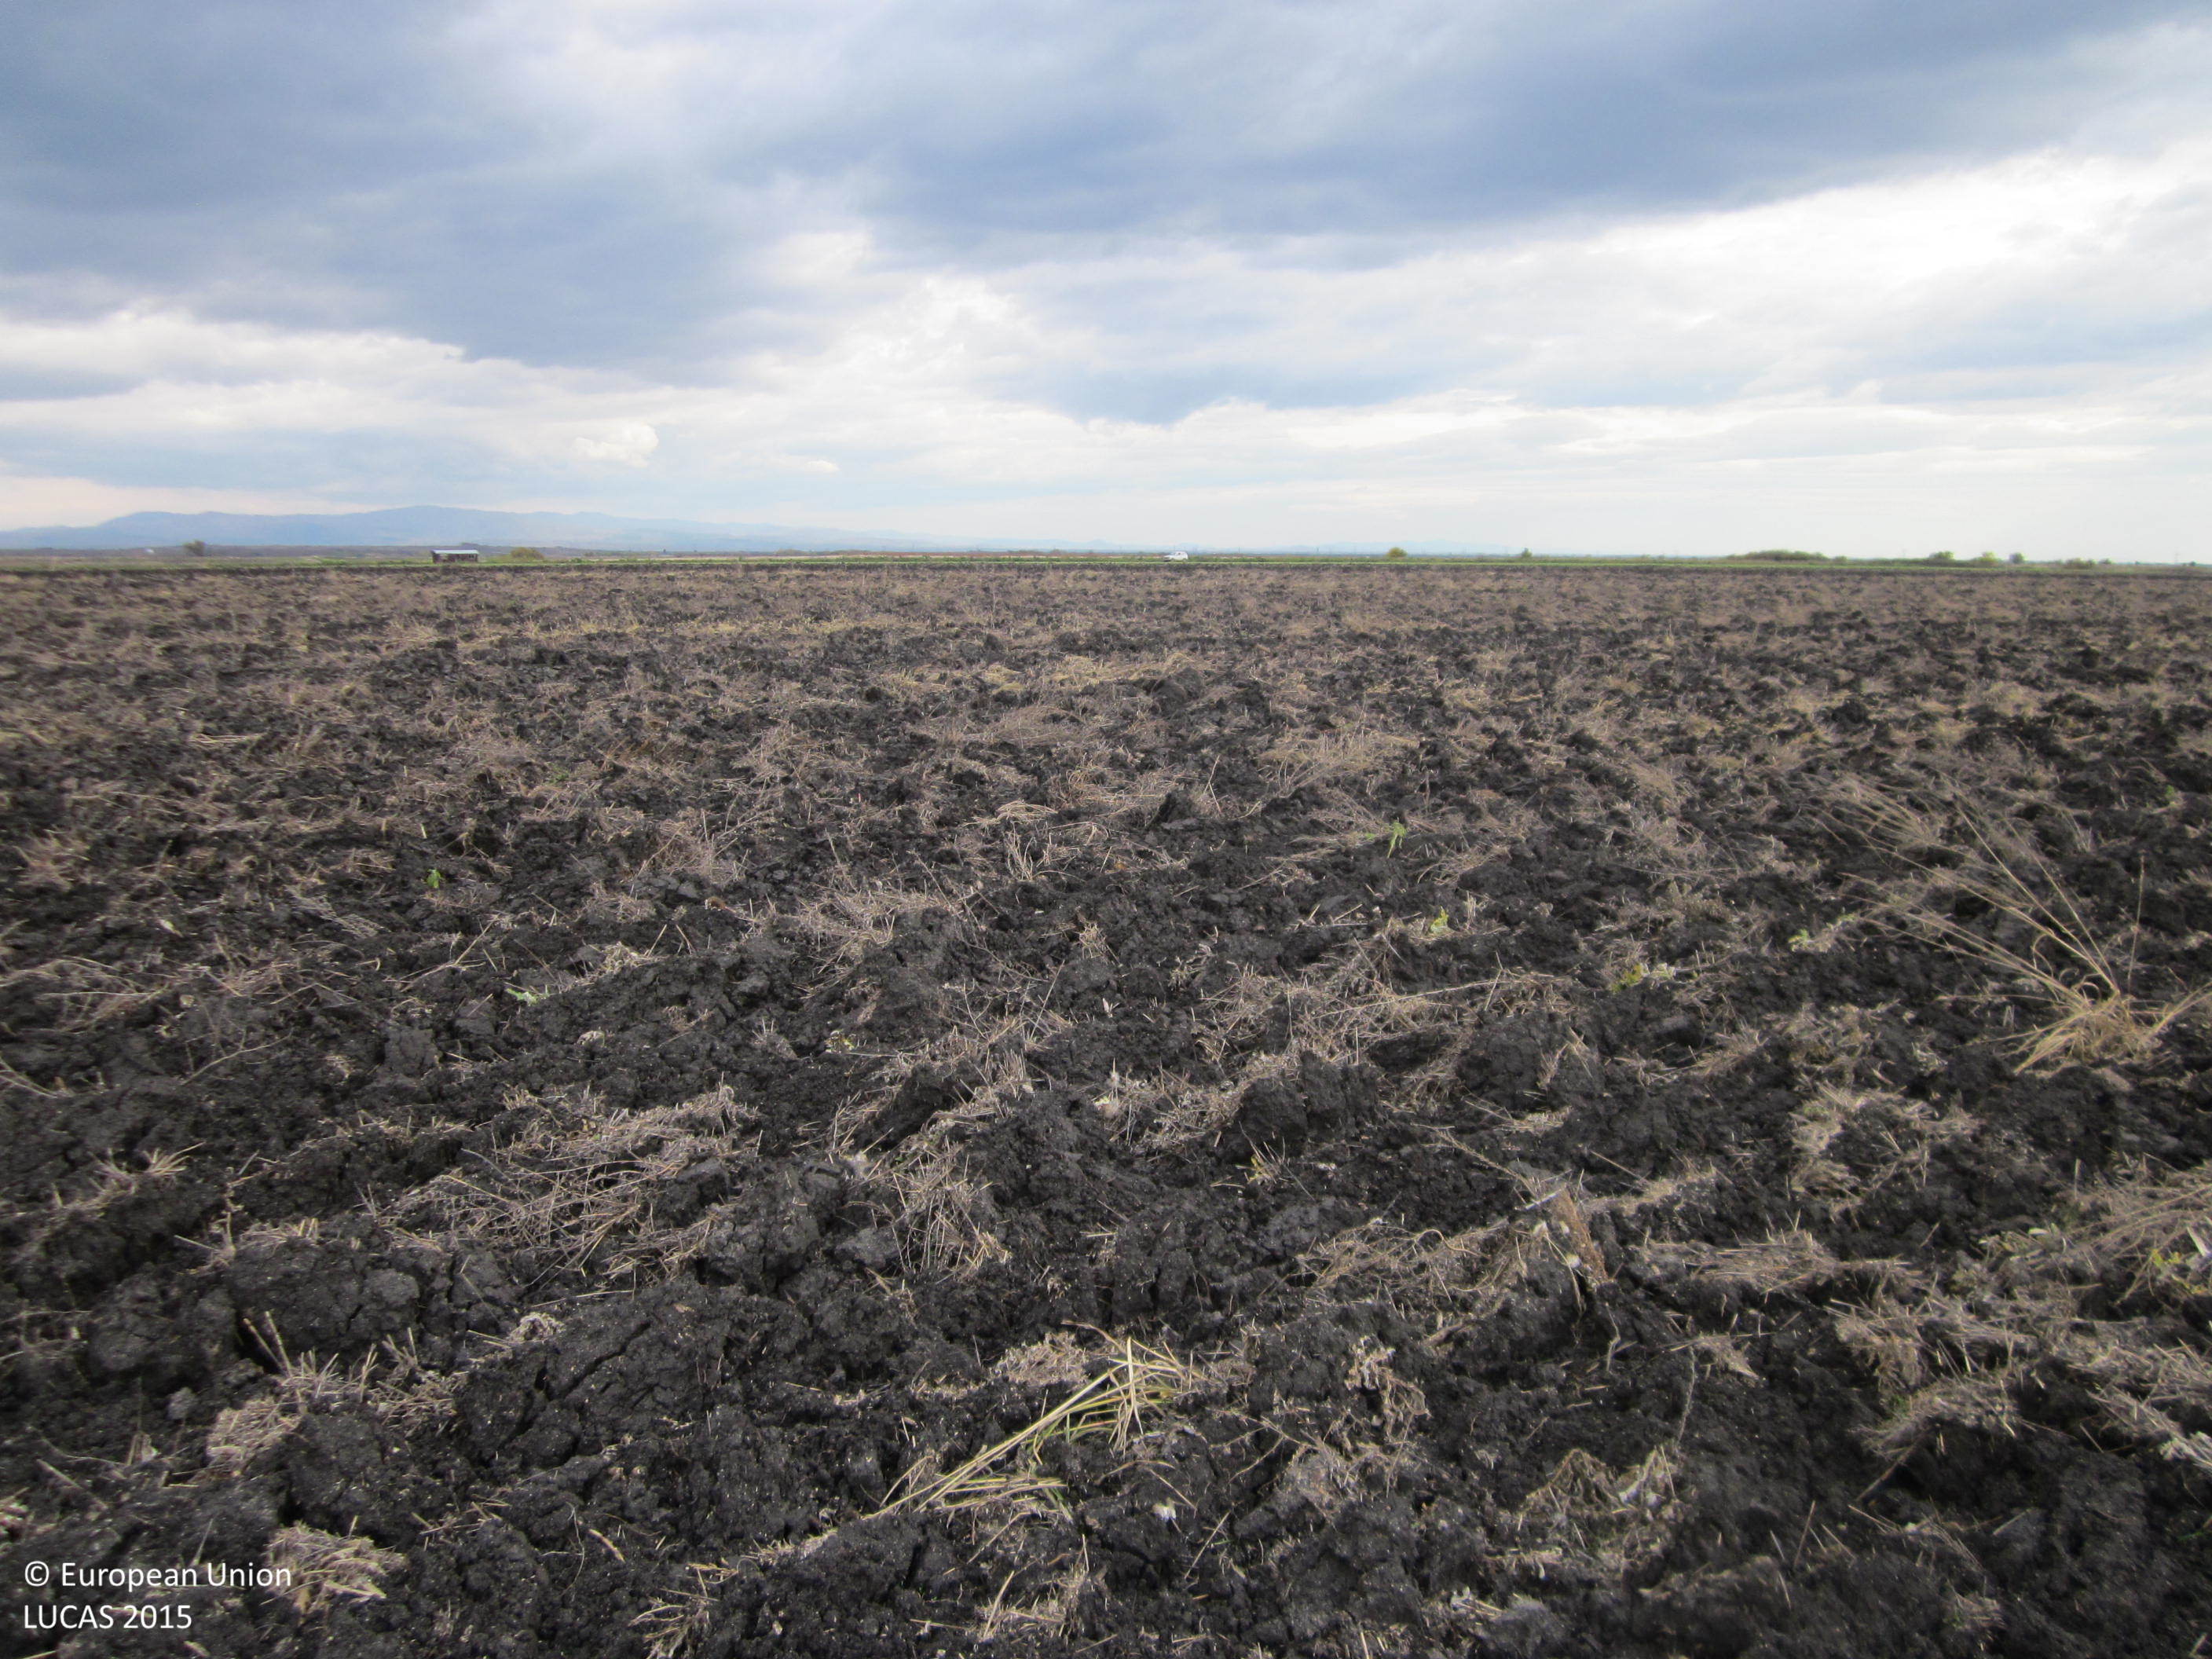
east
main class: Cropland
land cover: Common wheat
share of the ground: < 10 %
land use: Agriculture (excluding fallow land and kitchen gardens)
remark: Harvested field
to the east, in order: Common wheat
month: November
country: BG
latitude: 42.3685
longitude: 24.6606
